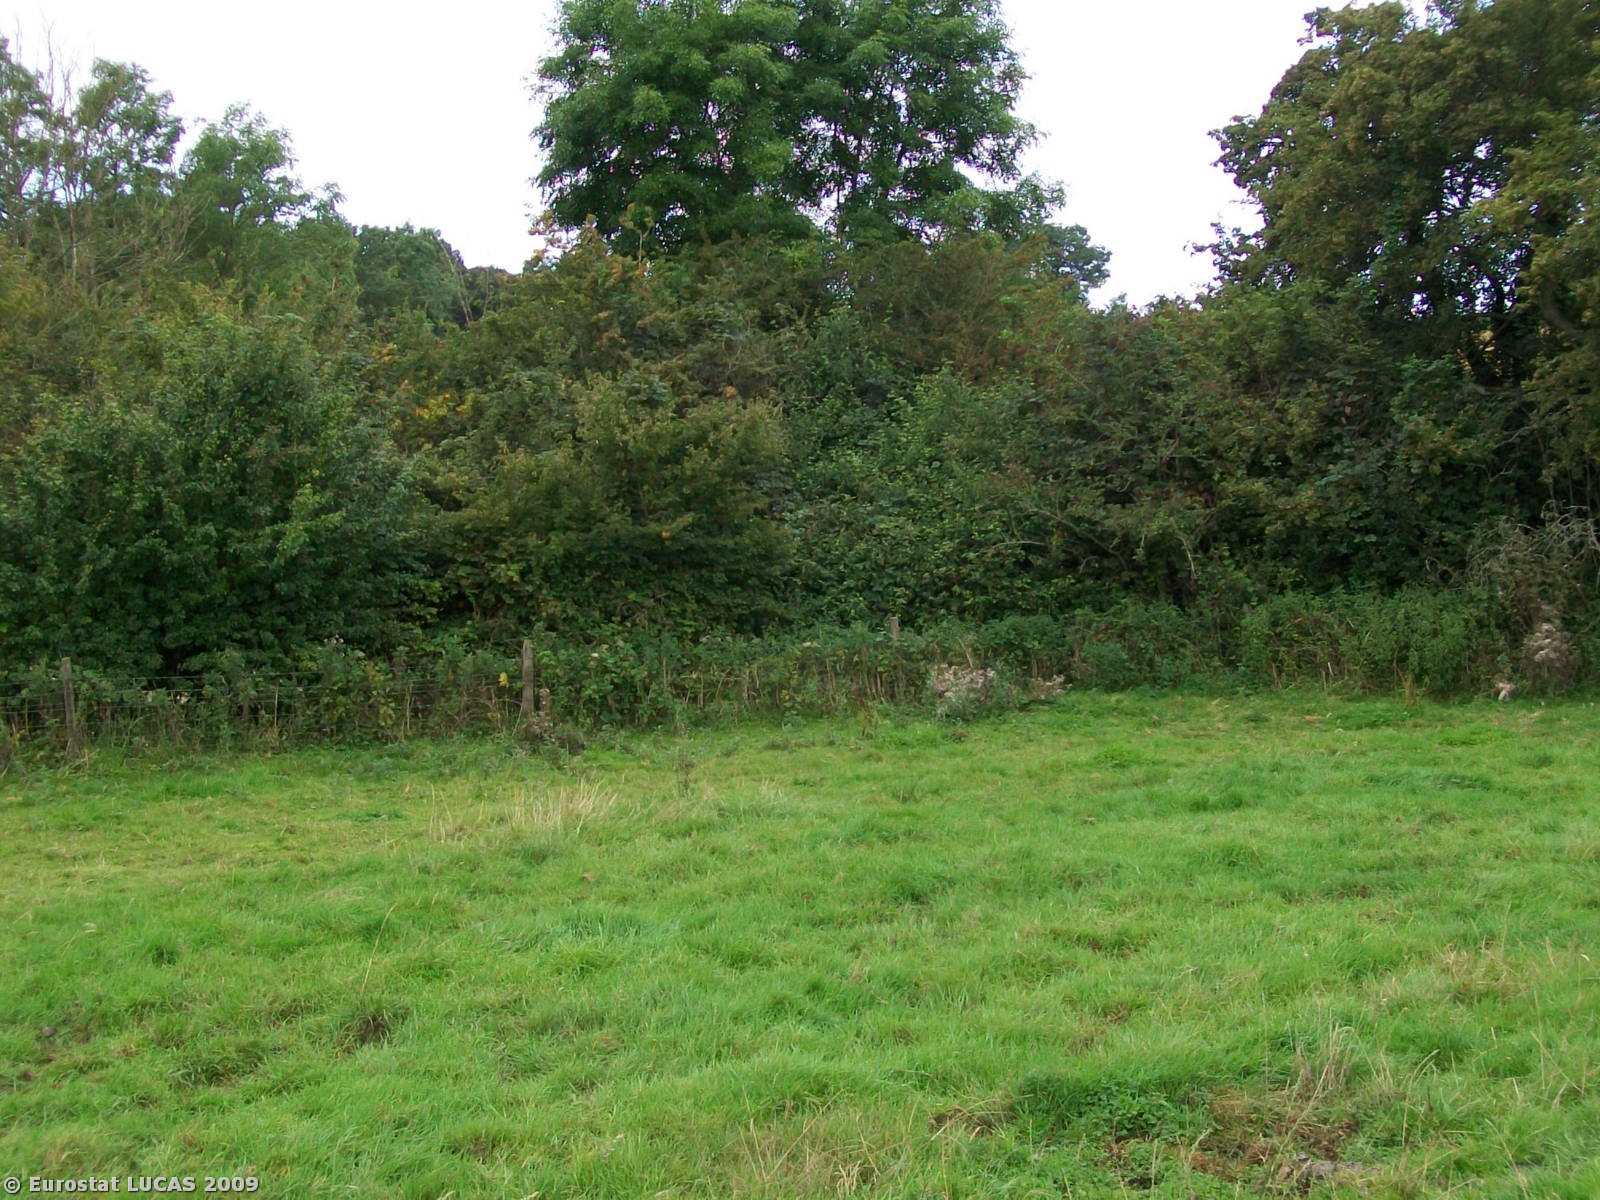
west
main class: Grassland
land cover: Grassland without tree/shrub cover
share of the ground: > 75 %
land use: Agriculture (excluding fallow land and kitchen gardens)
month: August
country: GB
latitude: 52.1161
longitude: -1.2191
